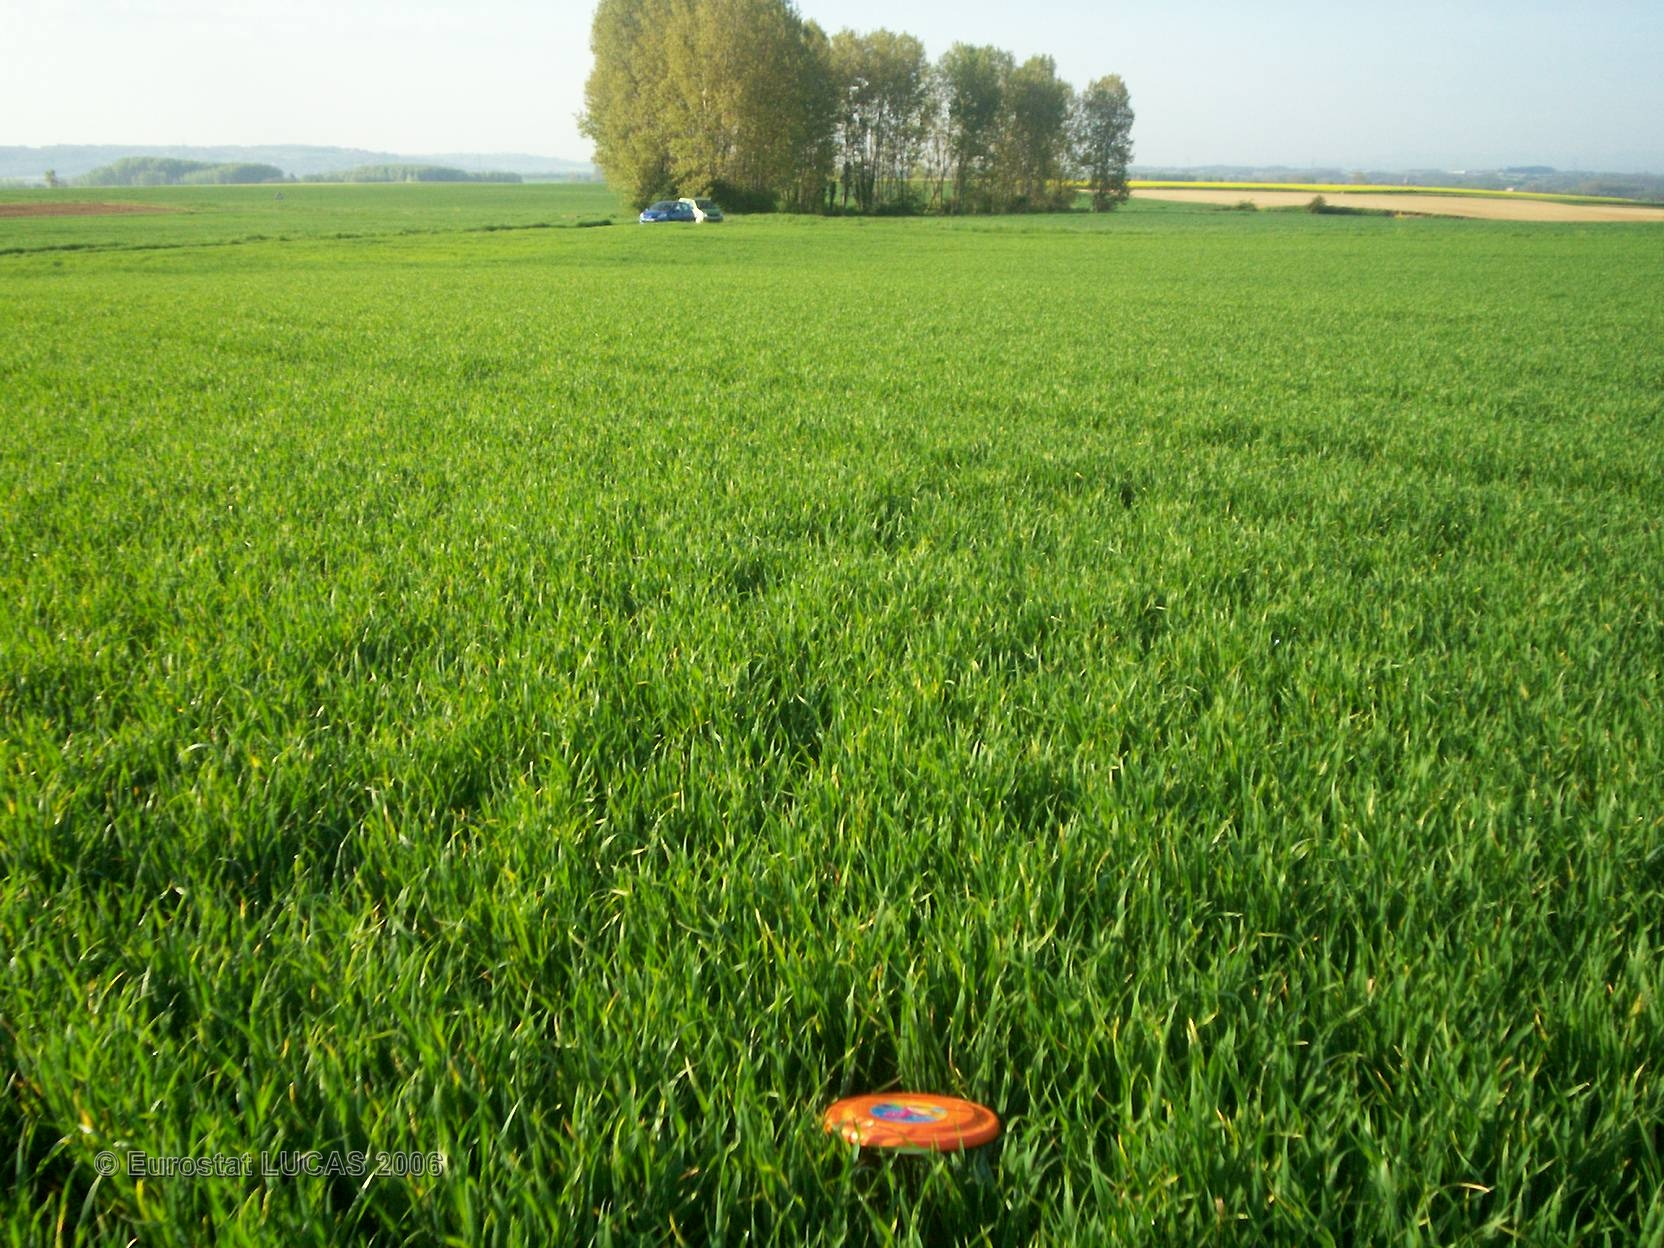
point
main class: Cropland
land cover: Common wheat
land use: Agriculture (excluding fallow land and kitchen gardens)
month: April
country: FR
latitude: 45.4510
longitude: 4.8513
